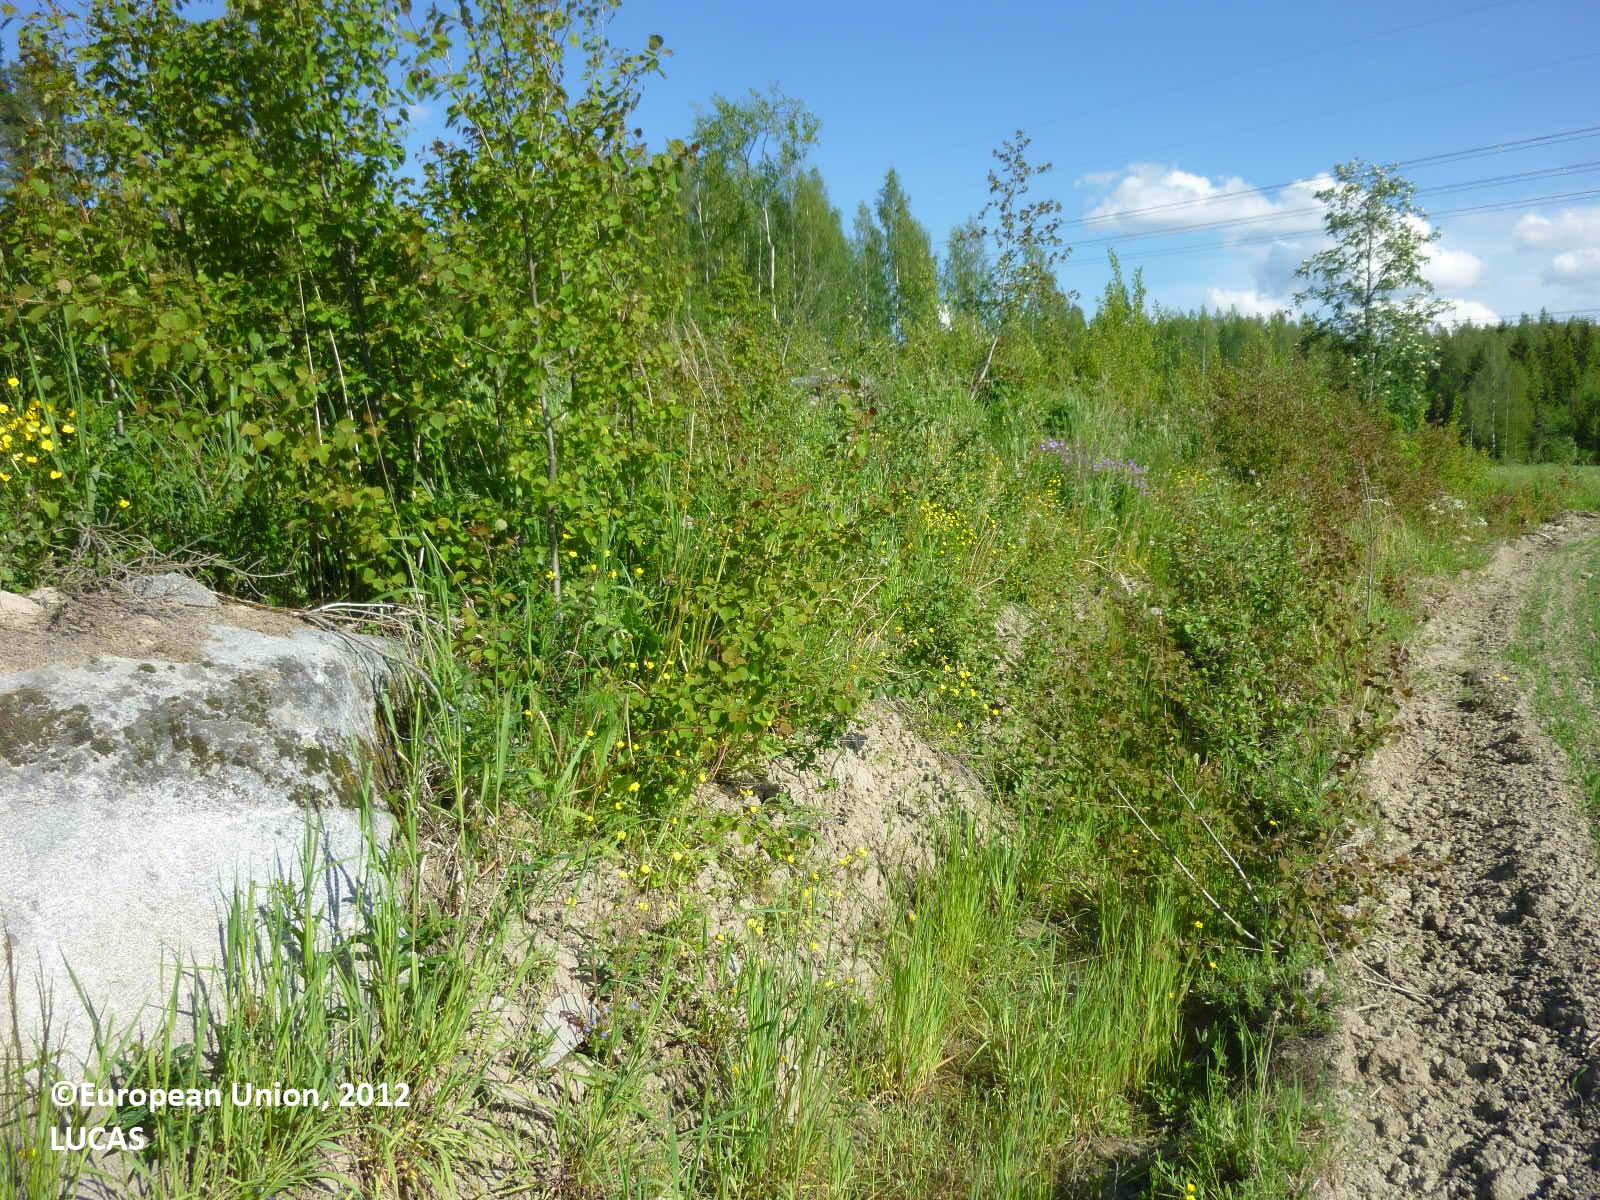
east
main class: Cropland
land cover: Oats
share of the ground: > 75 %
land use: Agriculture (excluding fallow land and kitchen gardens)
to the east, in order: Oats; Grass margins; Ditches and canals; Shrubland with sparse tree cover; Other bare soil; Ditches and canals; Grass margins; Paved roads, cycling and walking lanes; Grassland without tree/shrub cover; Ditches and canals; Spruce dominated mixed woodland; Spruce dominated coniferous woodland; Broadleaved woodland; Grassland with sparse tree/shrub cover
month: June
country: FI
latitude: 61.4233
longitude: 22.7933
